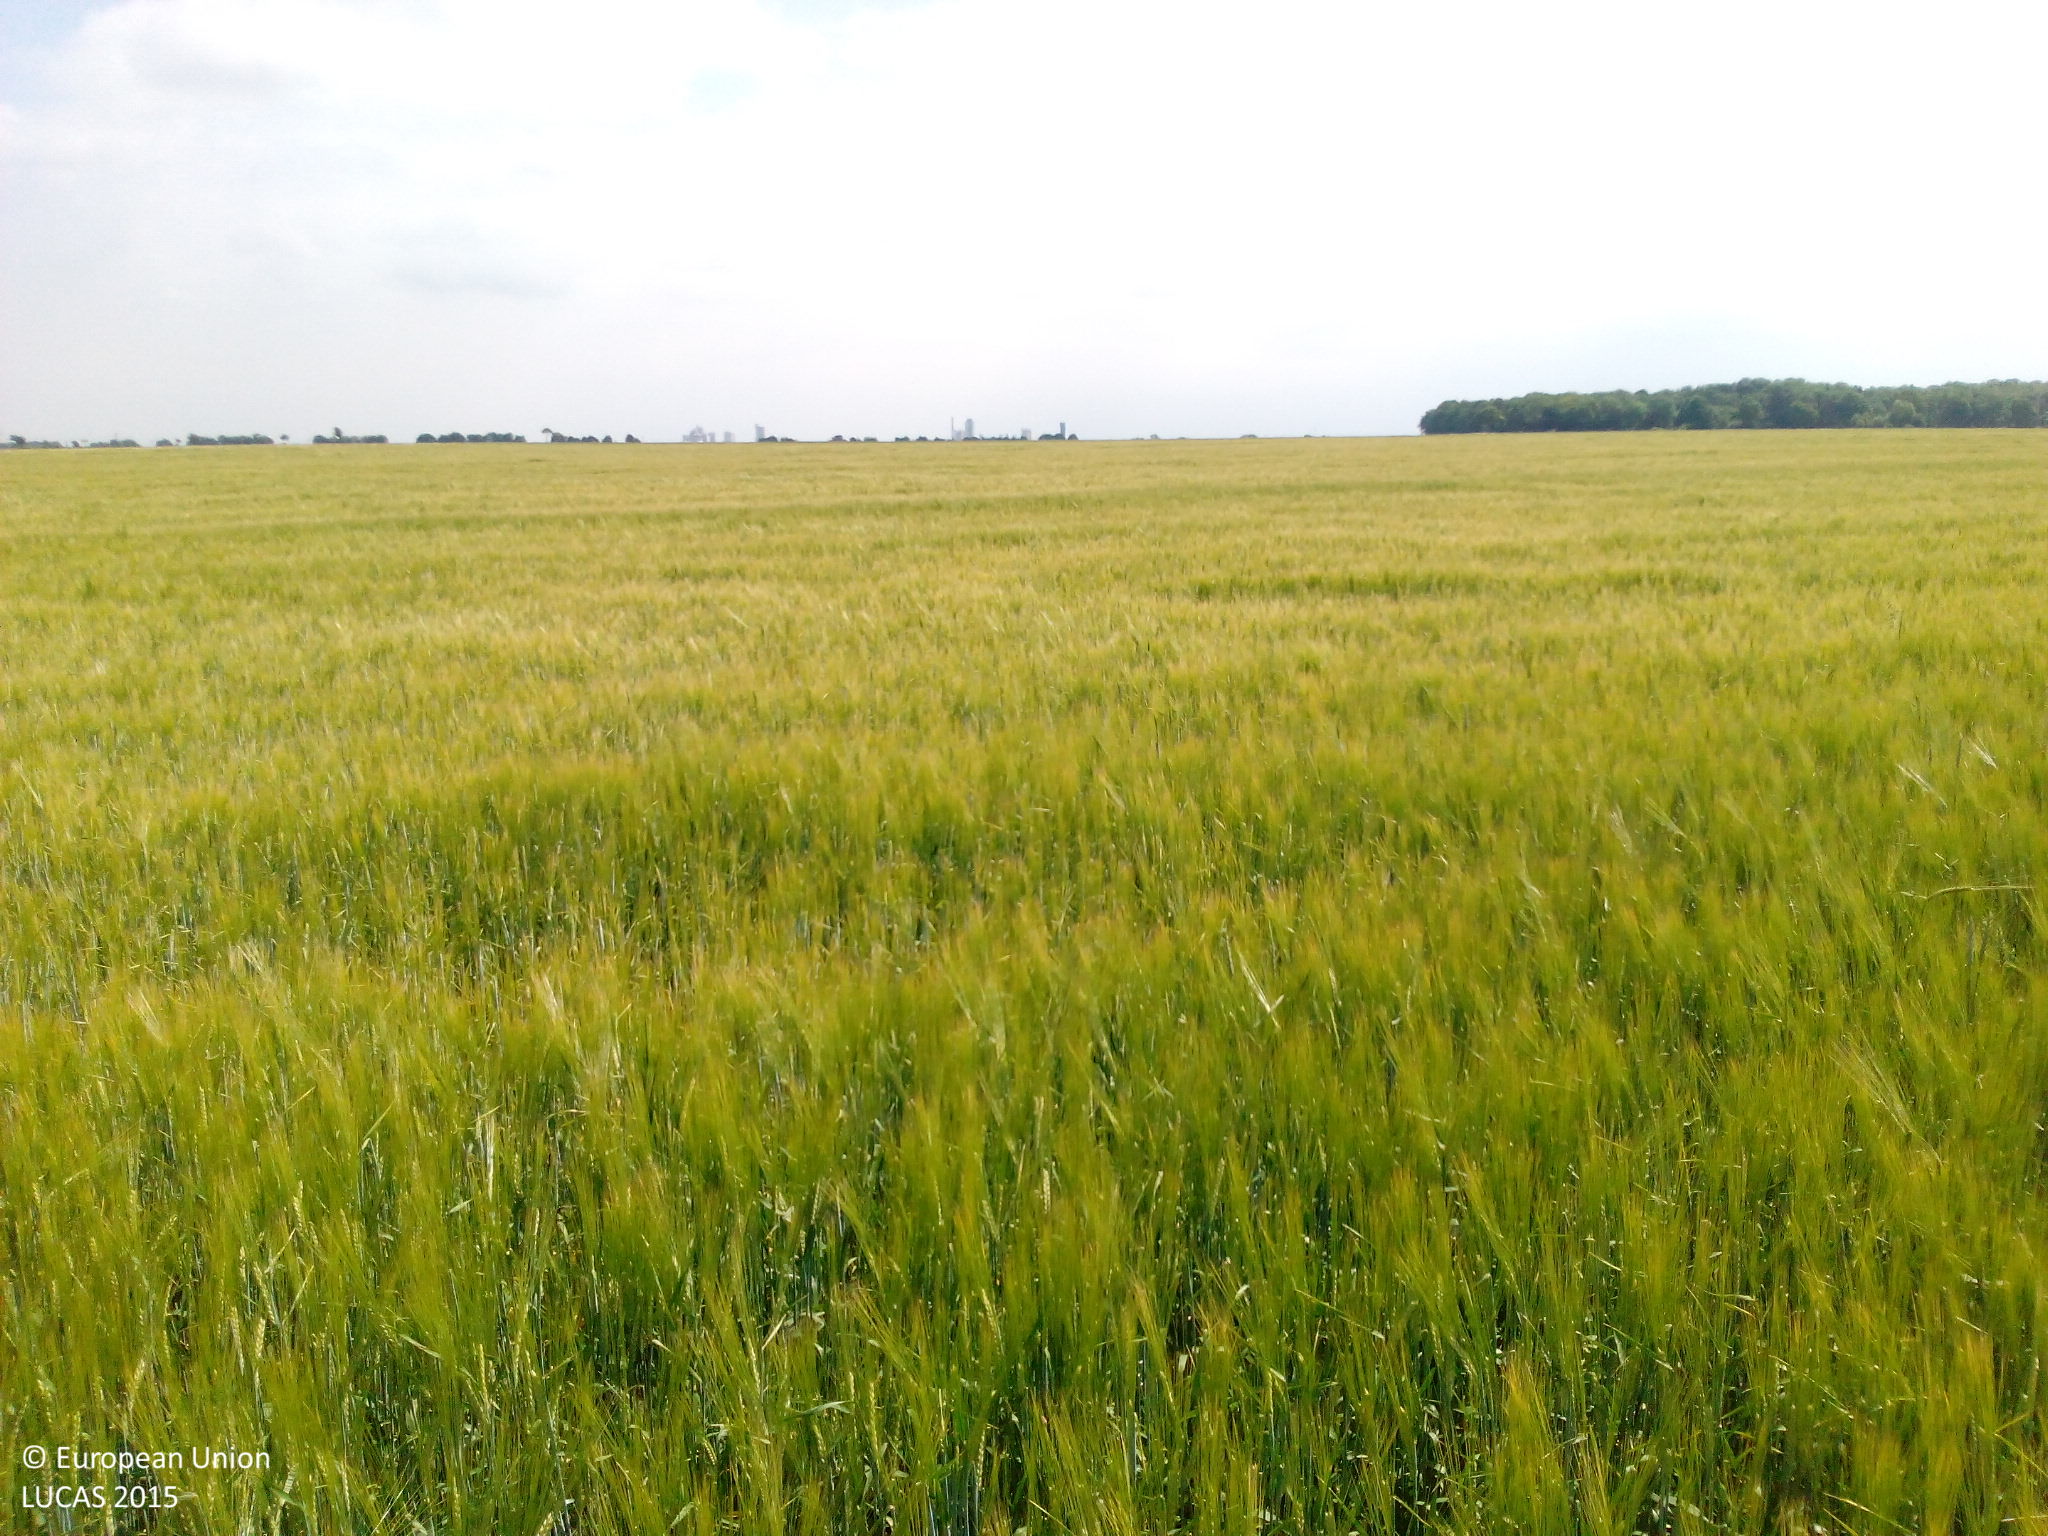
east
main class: Cropland
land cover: Barley
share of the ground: > 75 %
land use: Agriculture (excluding fallow land and kitchen gardens)
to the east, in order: Barley
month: June
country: DE
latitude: 51.6123
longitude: 8.4552
